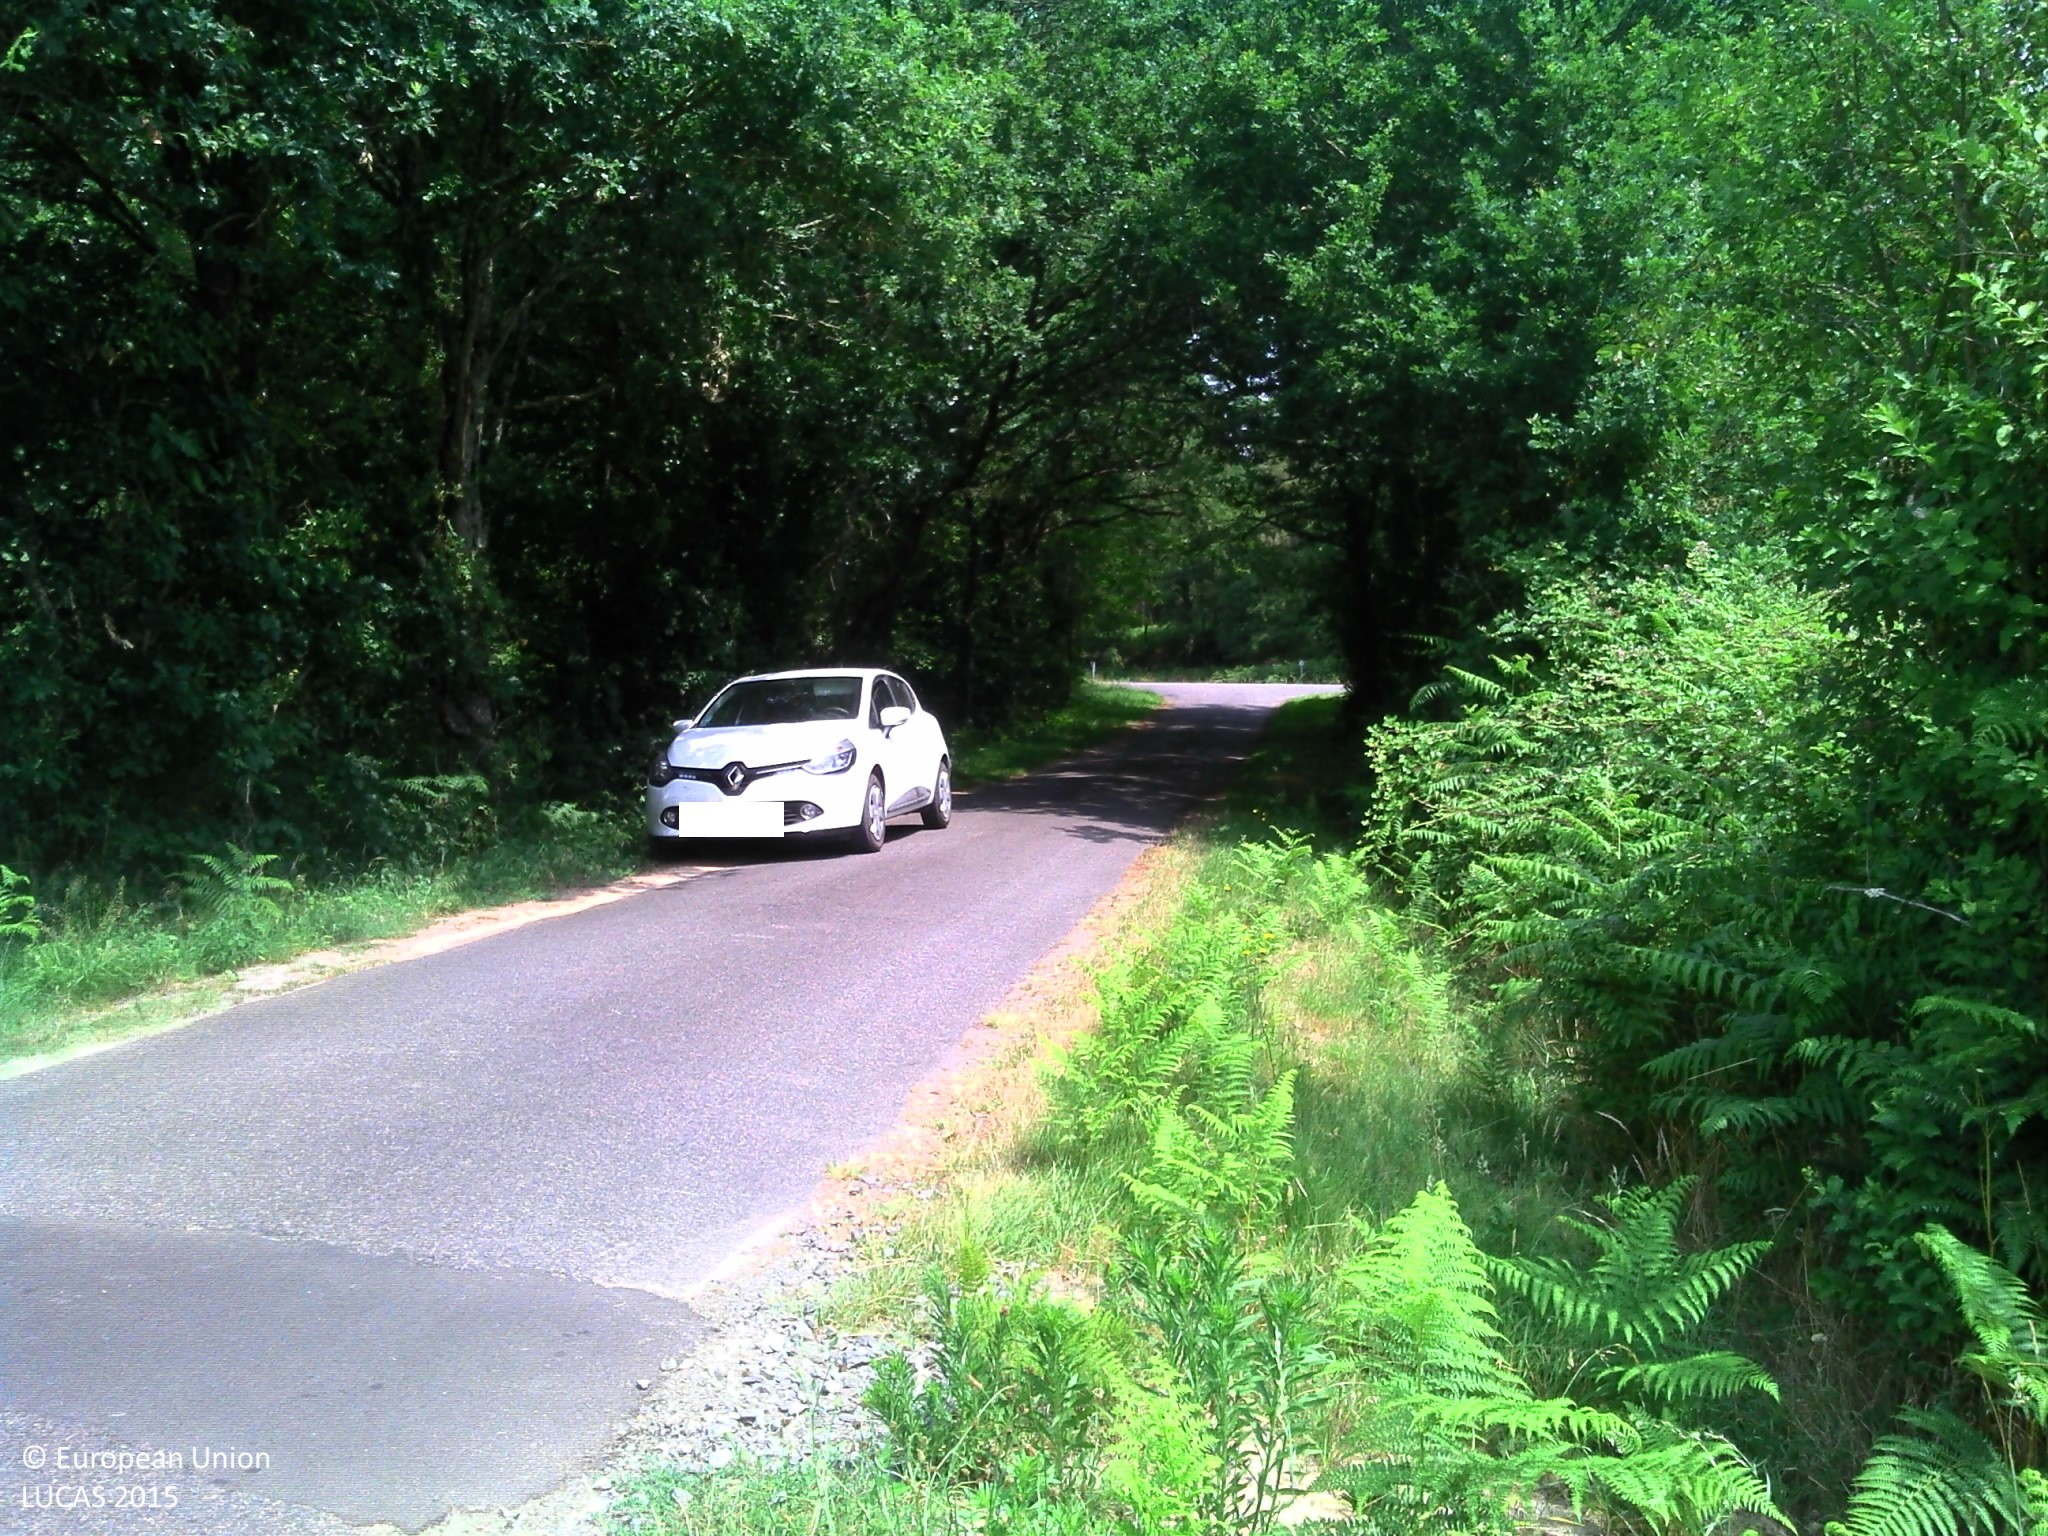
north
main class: Grassland
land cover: Grassland without tree/shrub cover
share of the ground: > 75 %
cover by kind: herbaceous plants 100 %
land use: Agriculture (excluding fallow land and kitchen gardens)
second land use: Residential
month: July
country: FR
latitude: 47.3253
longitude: 0.1184
